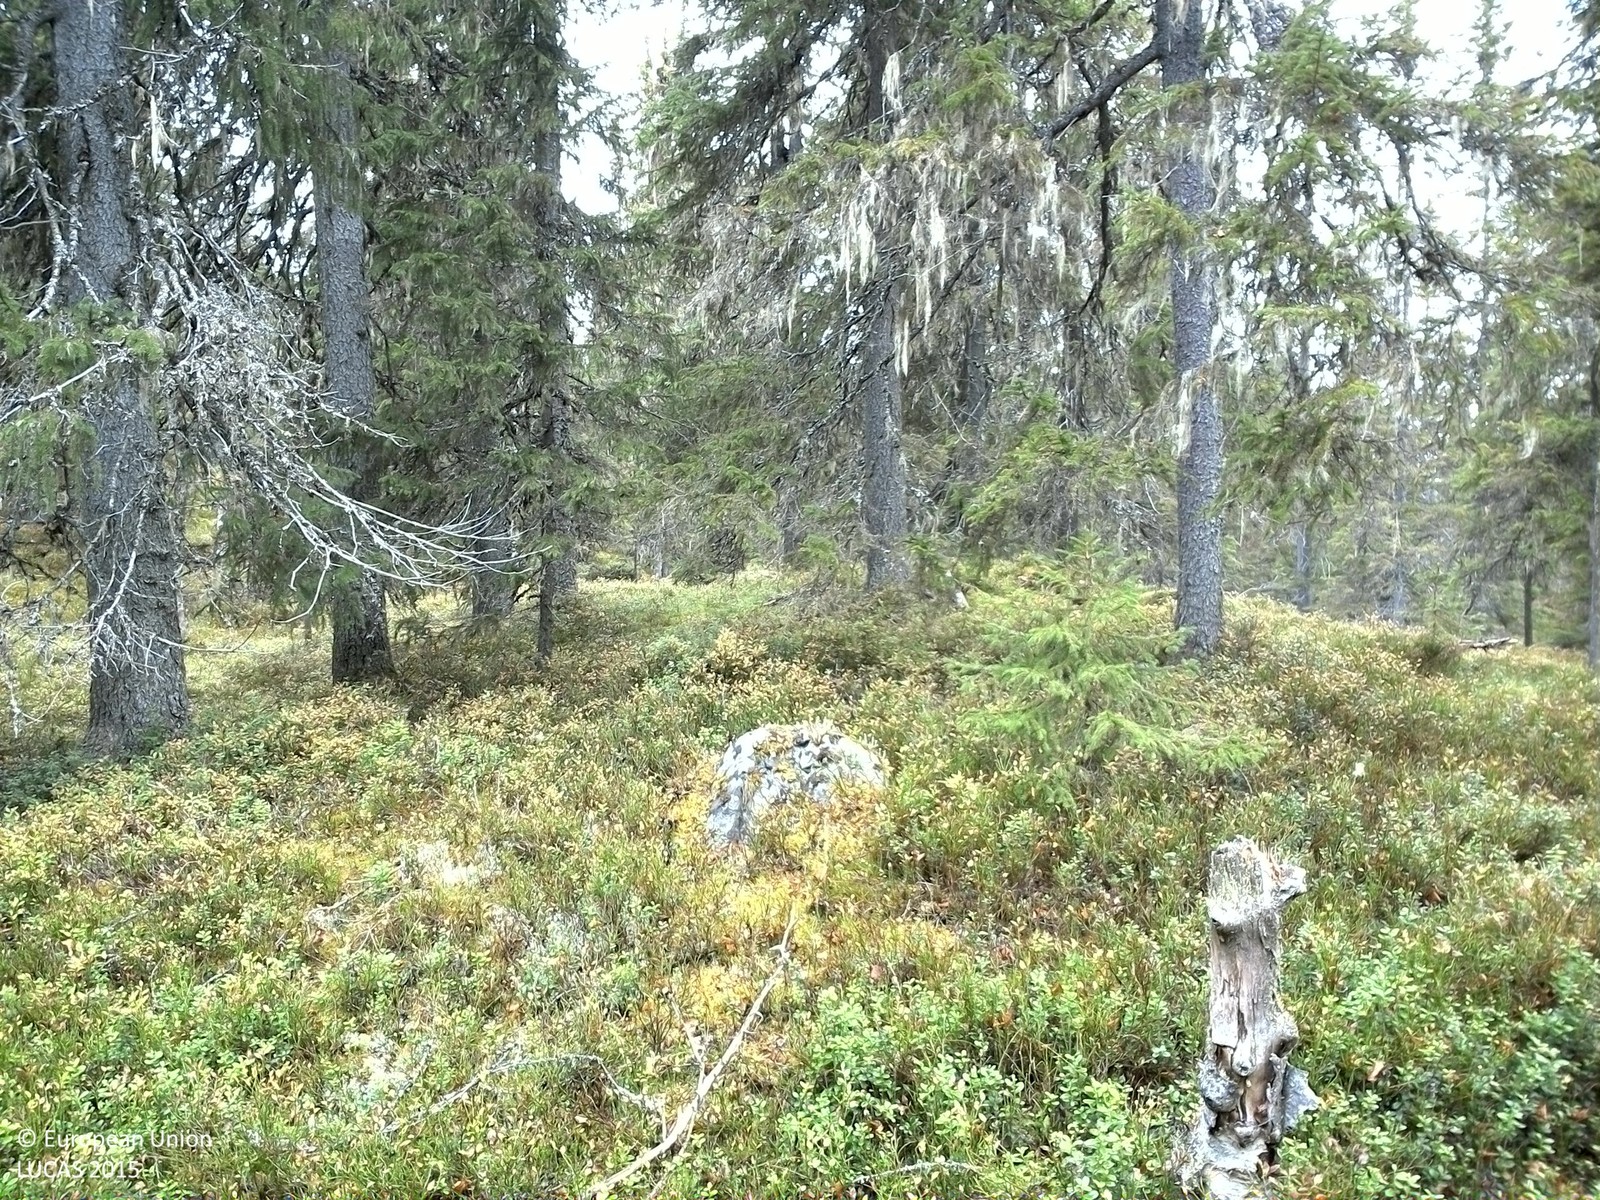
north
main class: Woodland
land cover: Spruce dominated coniferous woodland
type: boreal forest
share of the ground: 25 - 50 %
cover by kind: coniferous forest trees 45 %, shrubs 35 %, lichens and mosses 20 %
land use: Amenities, museums, leisure
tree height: > 5 m
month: October
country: SE
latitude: 61.3584
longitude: 14.3433
